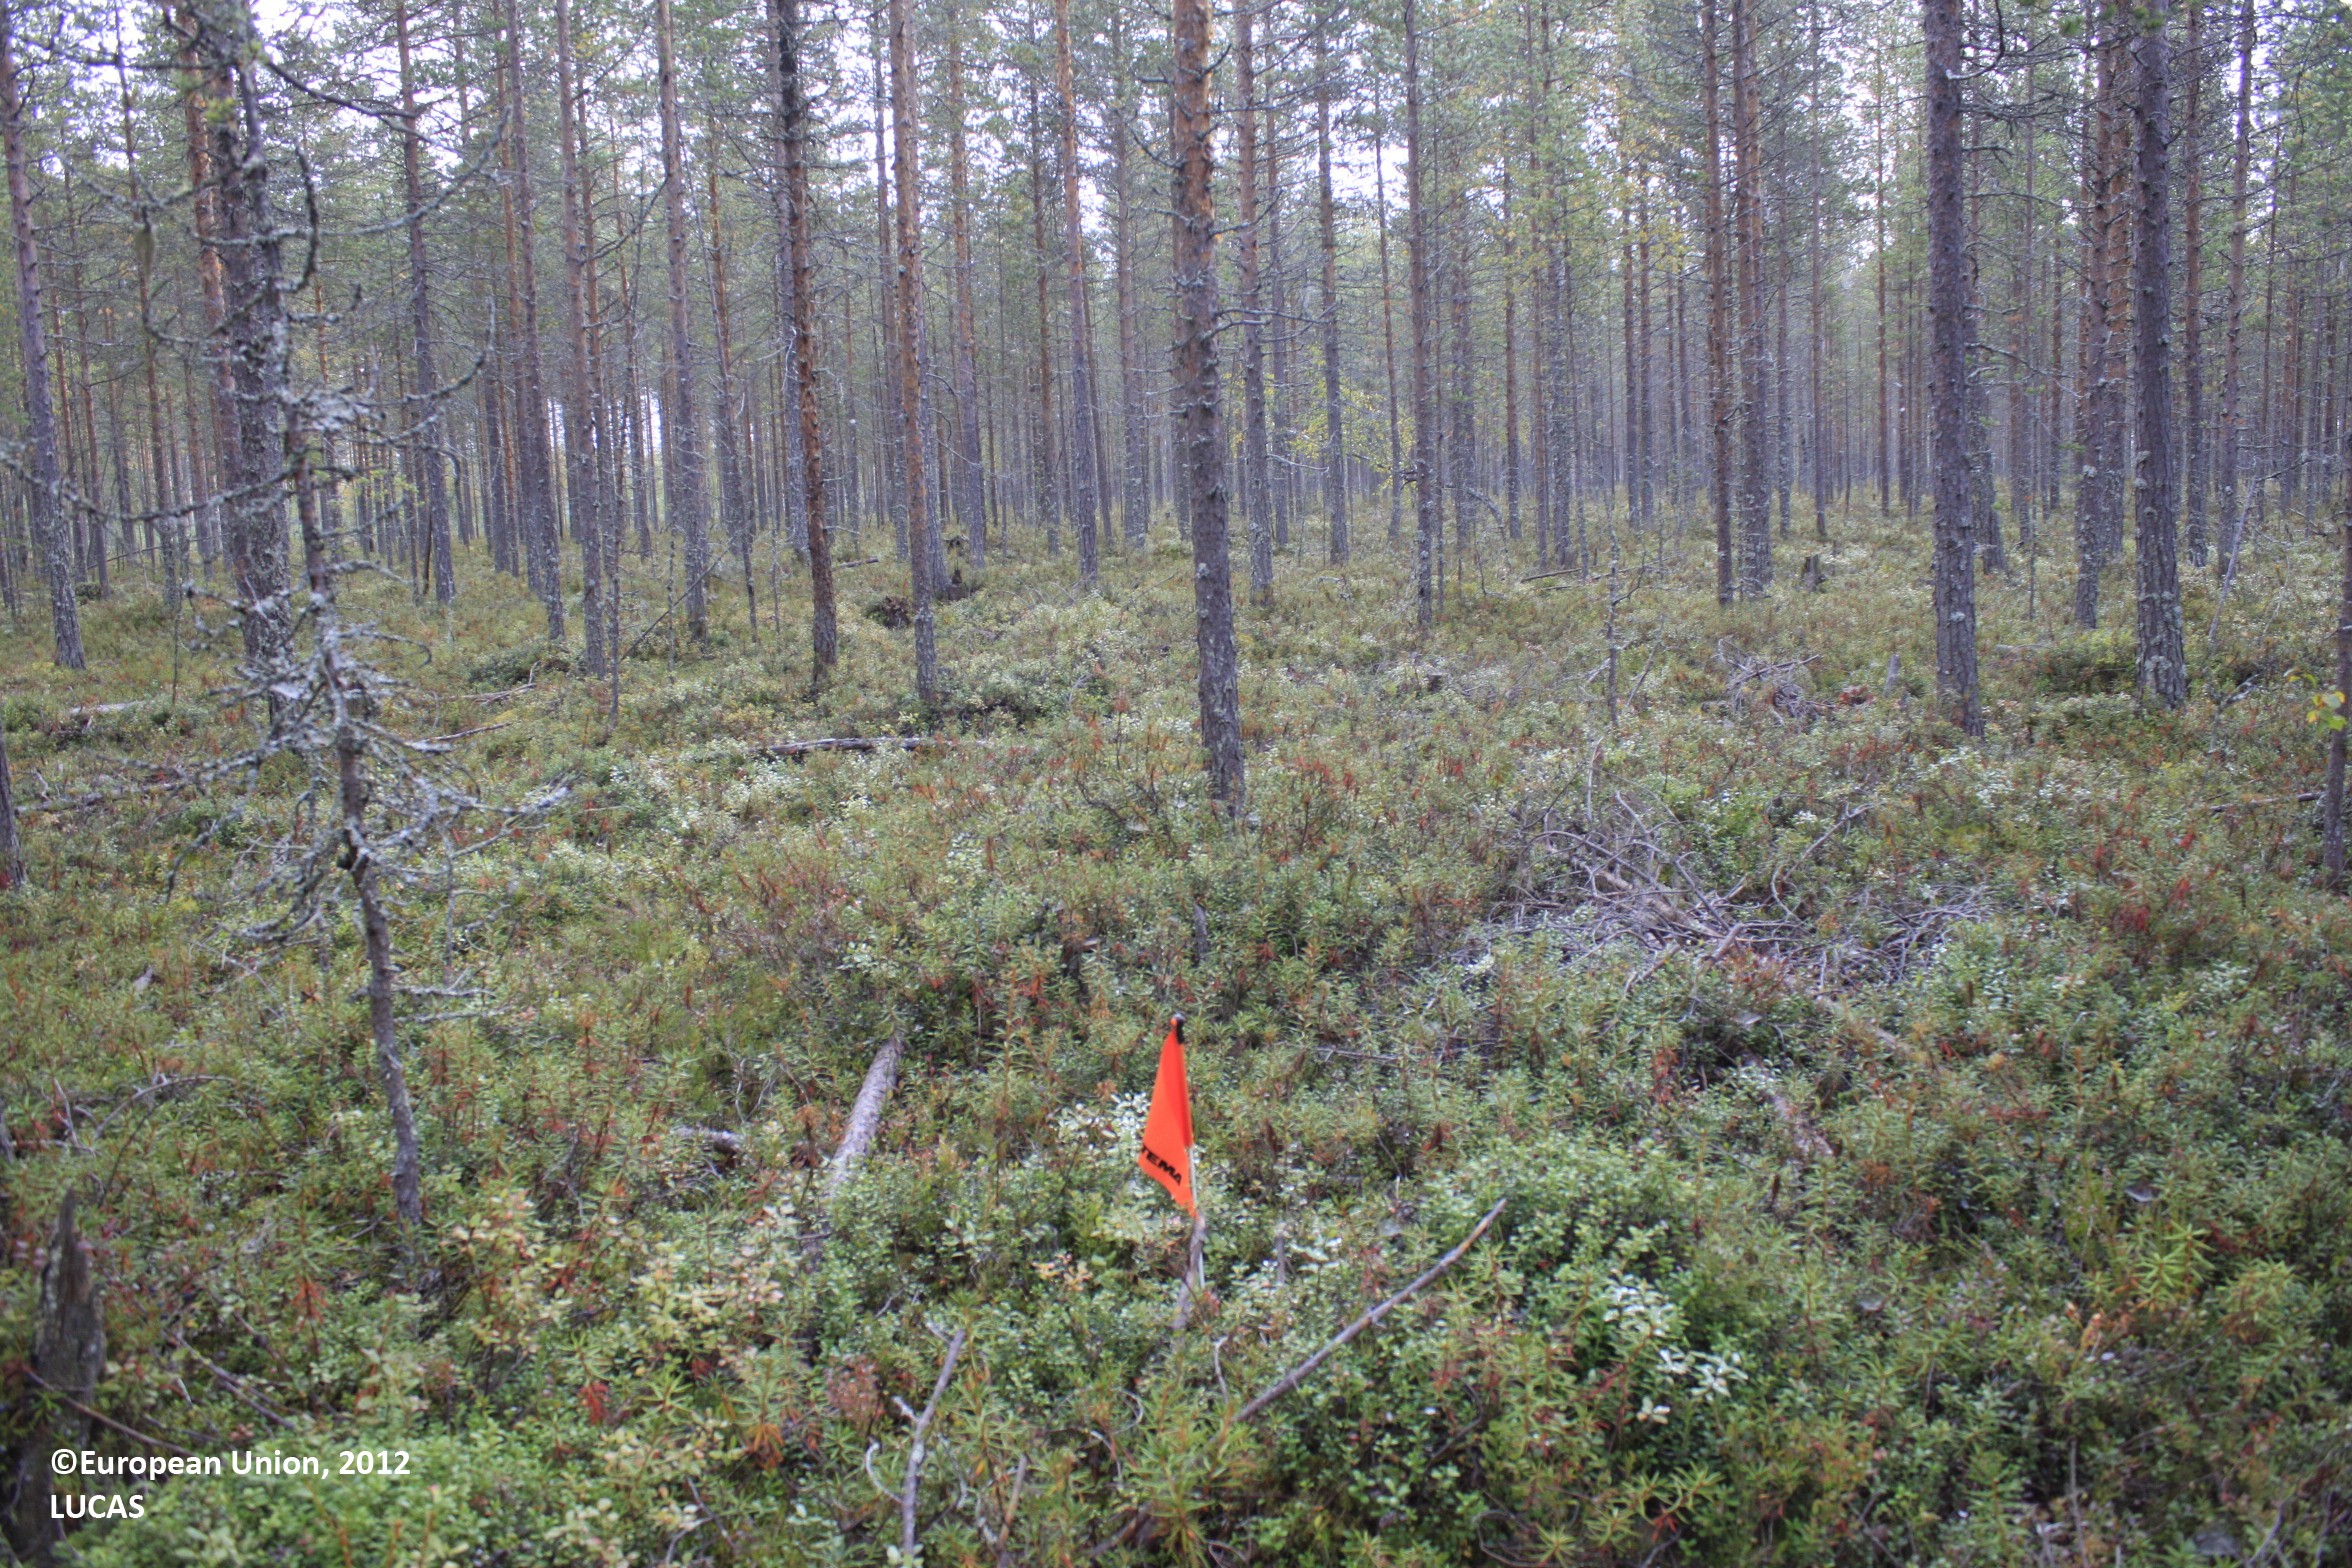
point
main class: Woodland
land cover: Pine dominated coniferous woodland
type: boreal forest
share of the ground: 25 - 50 %
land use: Forestry
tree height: > 5 m
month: September
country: FI
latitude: 65.1096
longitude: 26.9626
